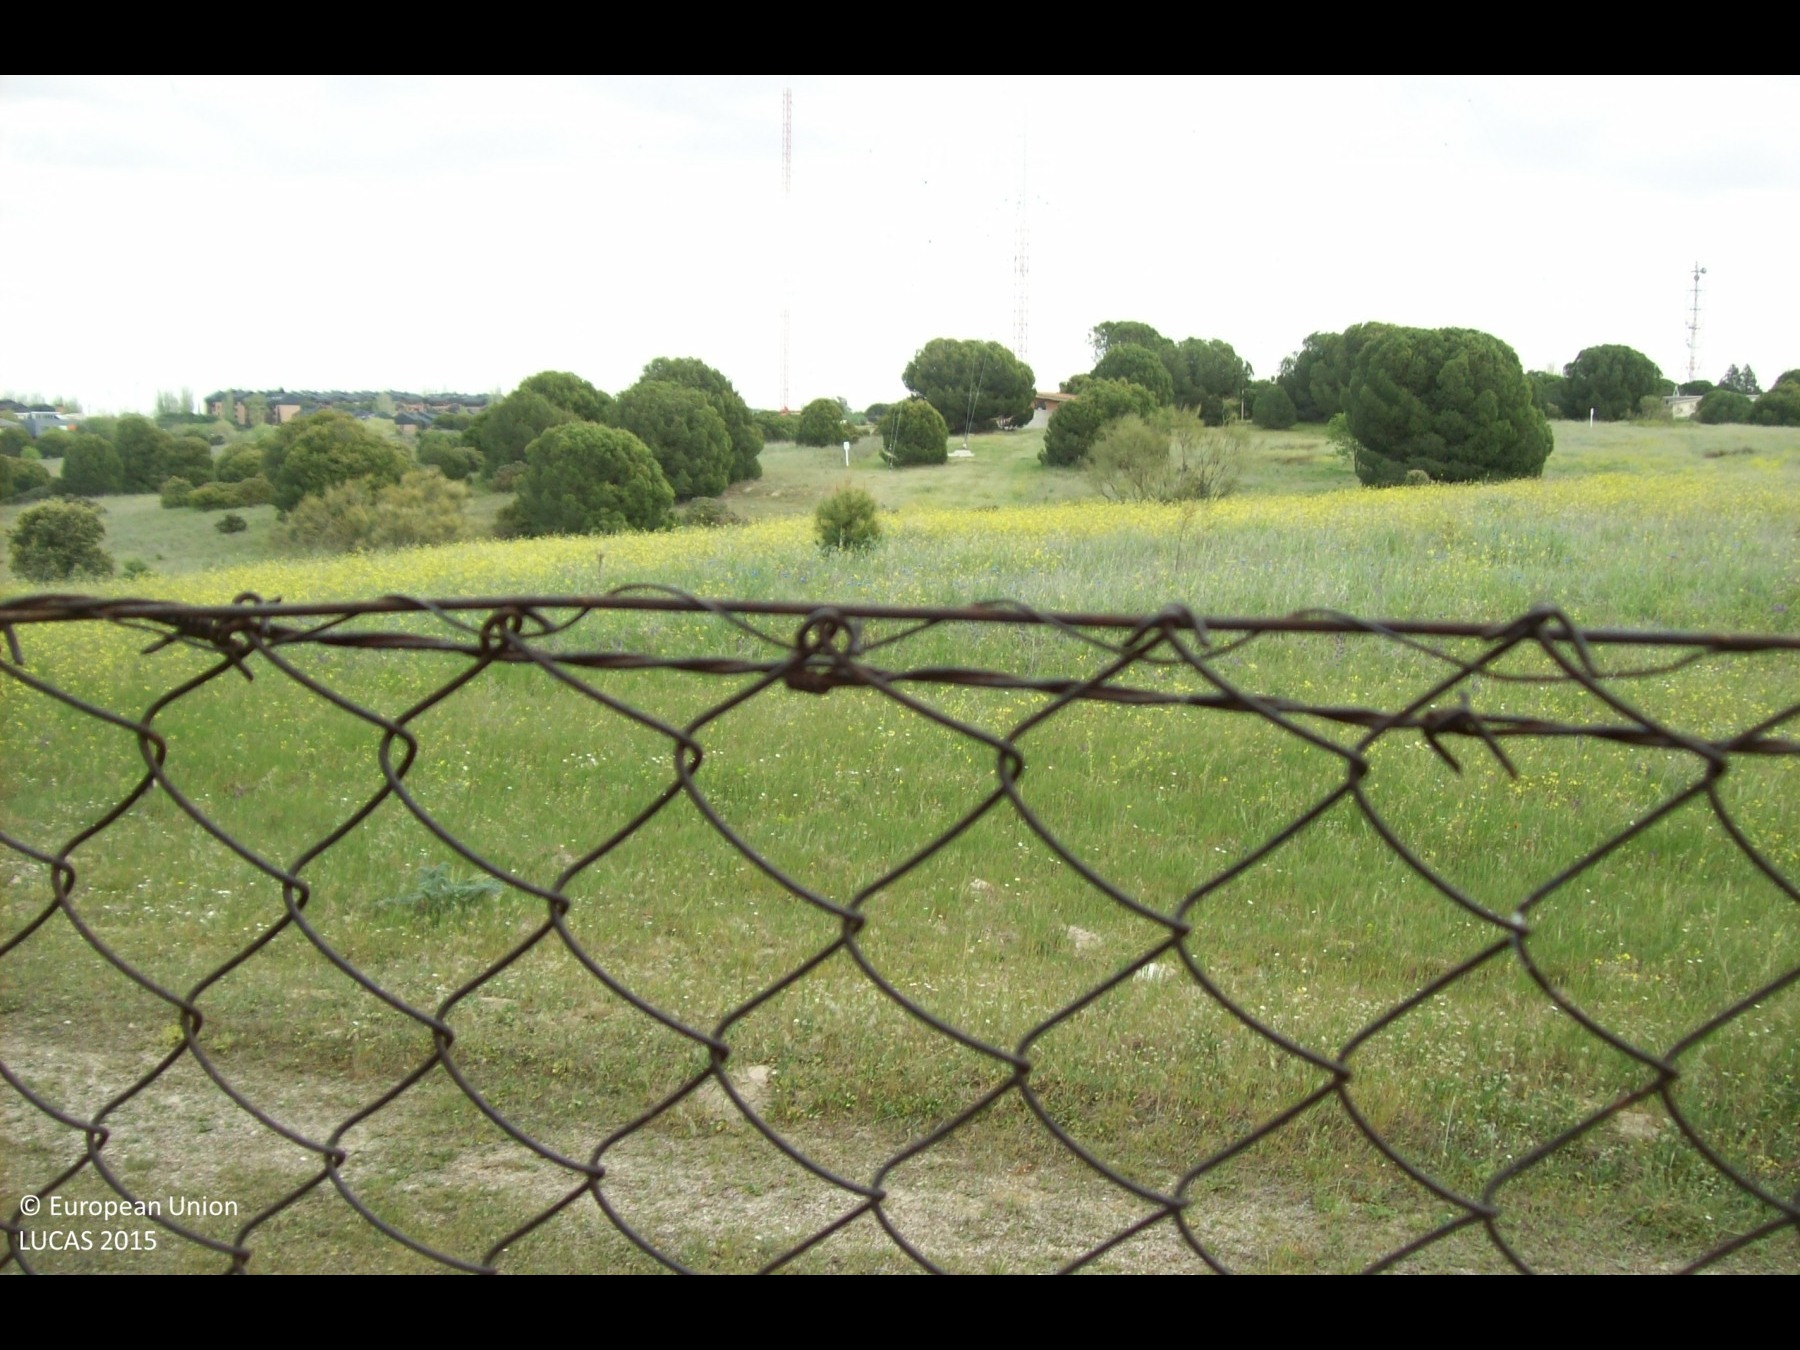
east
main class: Grassland
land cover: Grassland with sparse tree/shrub cover
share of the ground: > 75 %
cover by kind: herbaceous plants 95 %, coniferous forest trees 5 %
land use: Amenities, museums, leisure
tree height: < 5 m
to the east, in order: Grassland with sparse tree/shrub cover; Broadleaved woodland; Tracks; Grassland without tree/shrub cover; Grassland with sparse tree/shrub cover; Broadleaved woodland
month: April
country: ES
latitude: 40.4850
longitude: -3.8789
